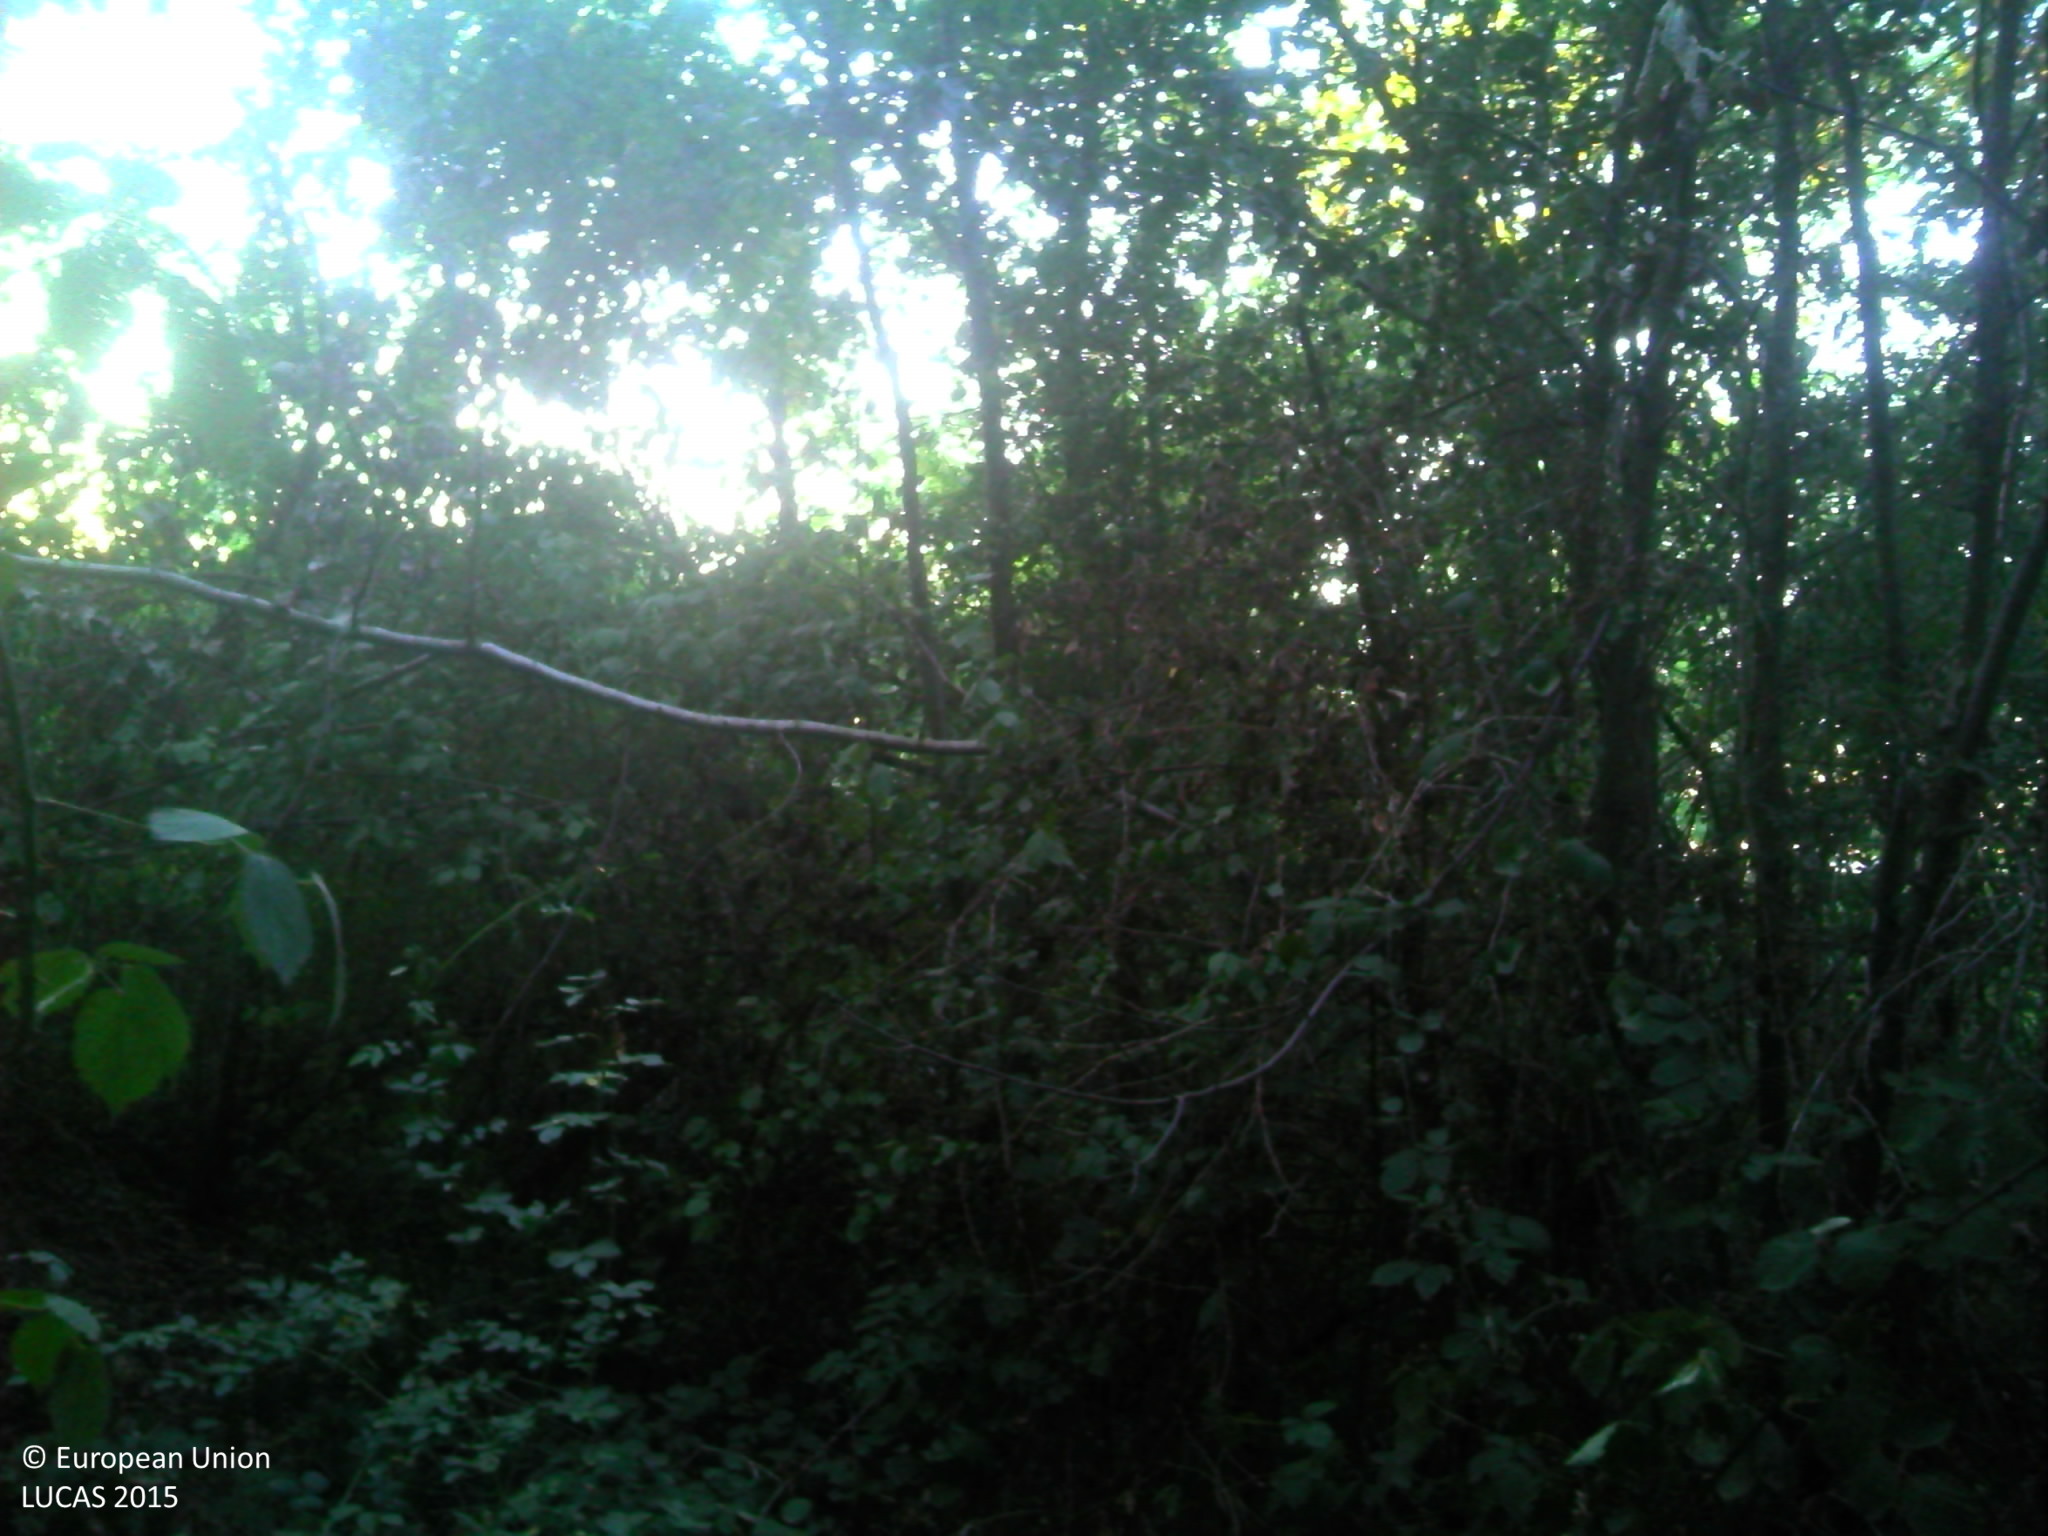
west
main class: Woodland
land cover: Broadleaved woodland
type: mesophytic deciduous forest
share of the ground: > 75 %
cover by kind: broadleaved forest trees 80 %, herbaceous plants 20 %
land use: Forestry
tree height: > 5 m
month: September
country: FR
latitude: 45.2067
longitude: 5.0270
